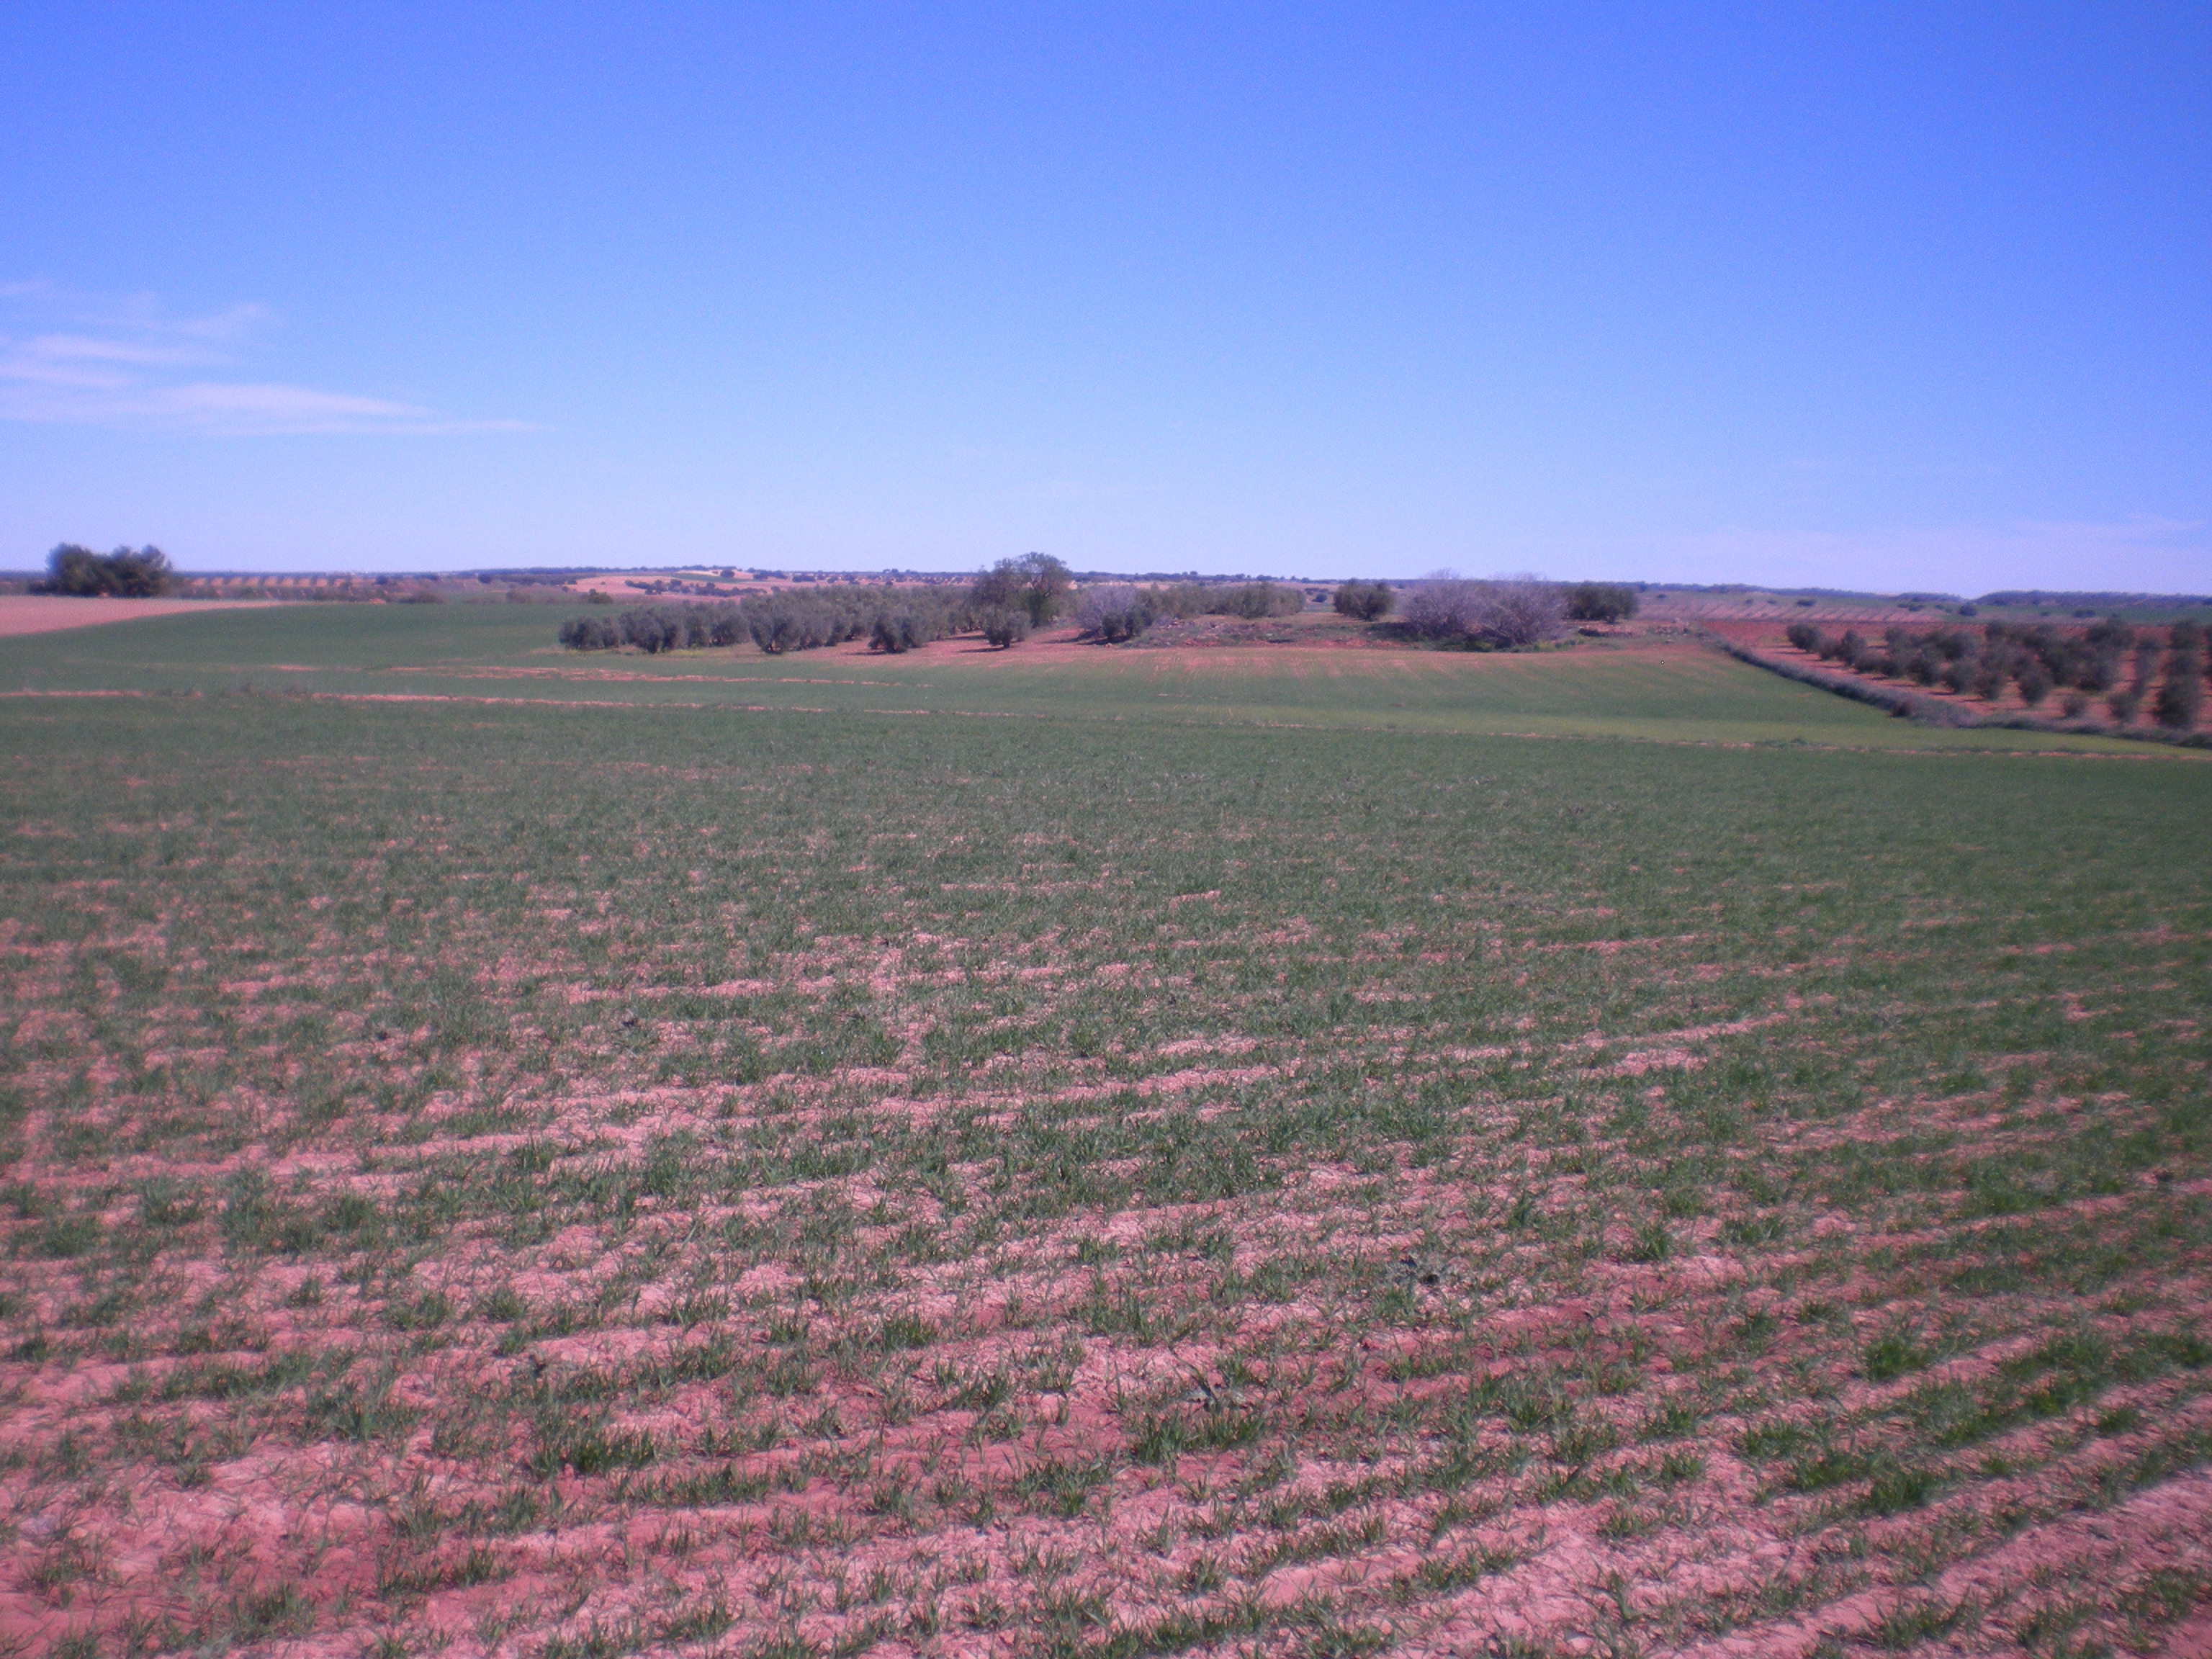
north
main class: Cropland
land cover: Barley
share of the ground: 25 - 50 %
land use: Agriculture (excluding fallow land and kitchen gardens)
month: April
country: ES
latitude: 38.7755
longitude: -3.0025
